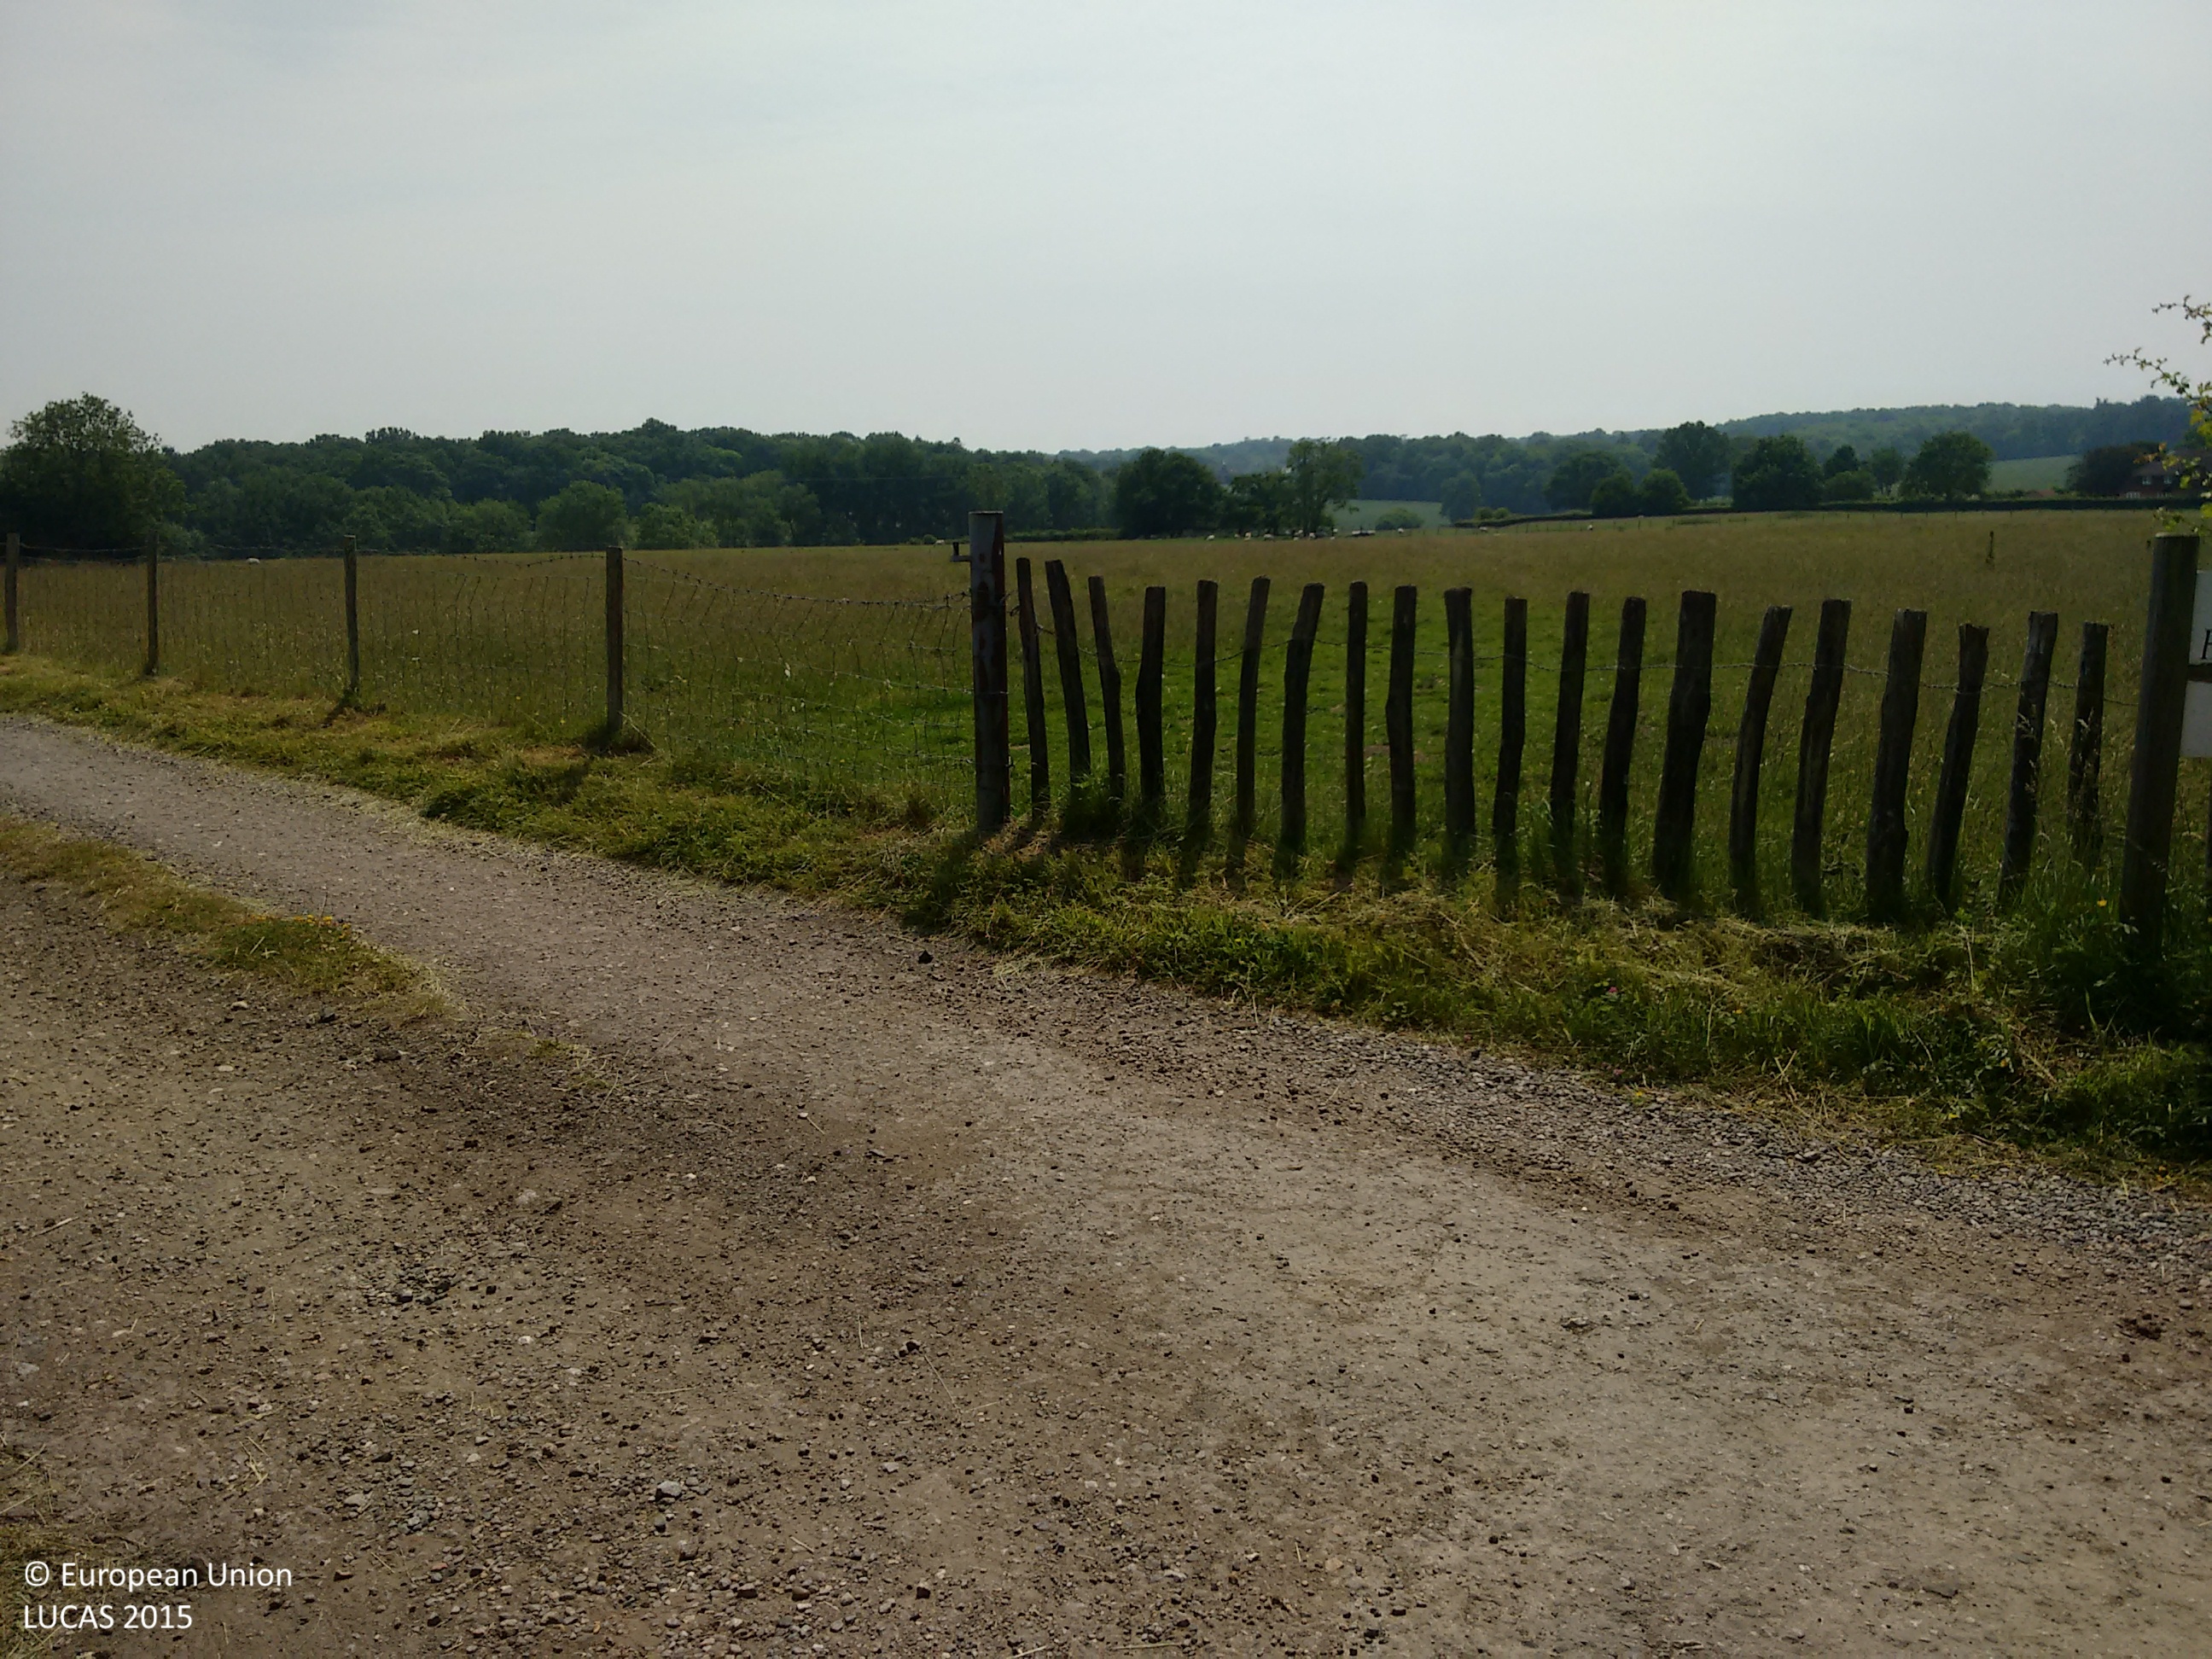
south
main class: Grassland
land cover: Grassland without tree/shrub cover
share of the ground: > 75 %
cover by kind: herbaceous plants 100 %
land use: Agriculture (excluding fallow land and kitchen gardens)
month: June
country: GB
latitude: 51.0970
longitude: 0.3607
